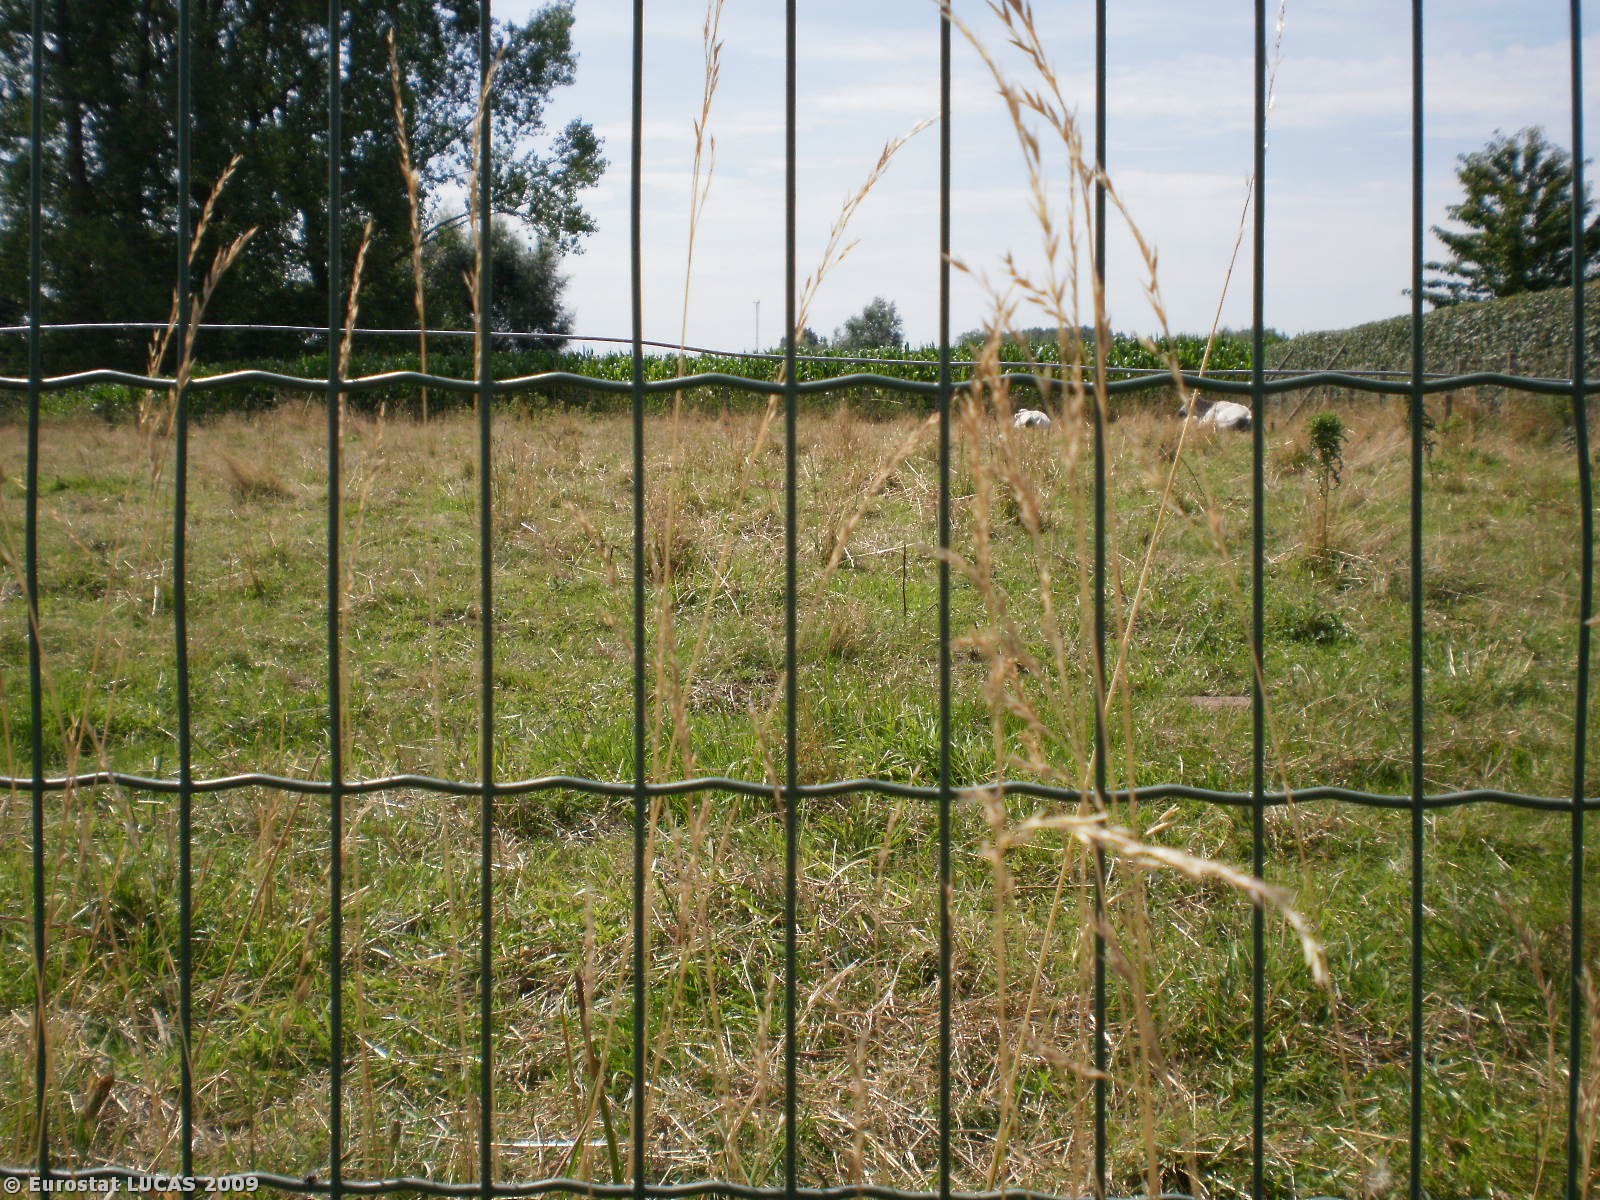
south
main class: Grassland
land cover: Grassland without tree/shrub cover
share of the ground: > 75 %
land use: Agriculture (excluding fallow land and kitchen gardens)
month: July
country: BE
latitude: 51.0470
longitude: 4.2179
